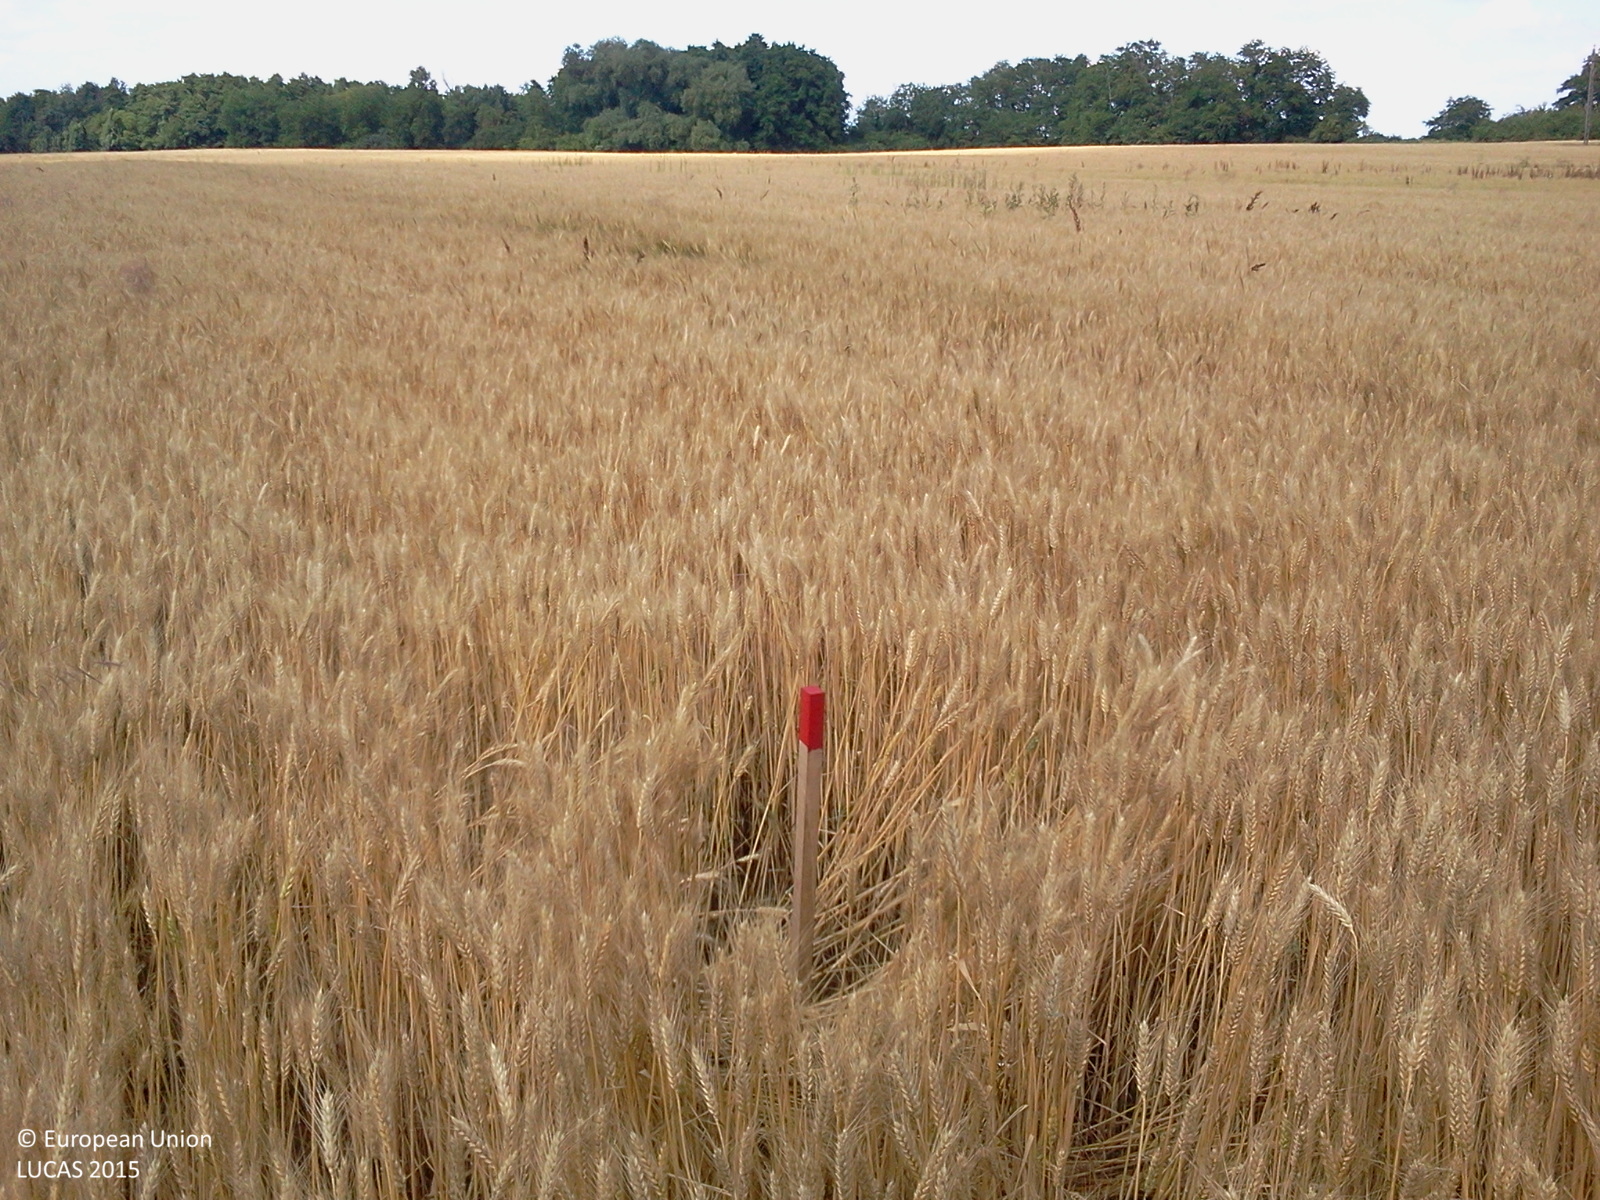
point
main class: Cropland
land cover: Durum wheat
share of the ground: > 75 %
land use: Agriculture (excluding fallow land and kitchen gardens)
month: June
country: HU
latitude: 46.9244
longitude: 17.1621
